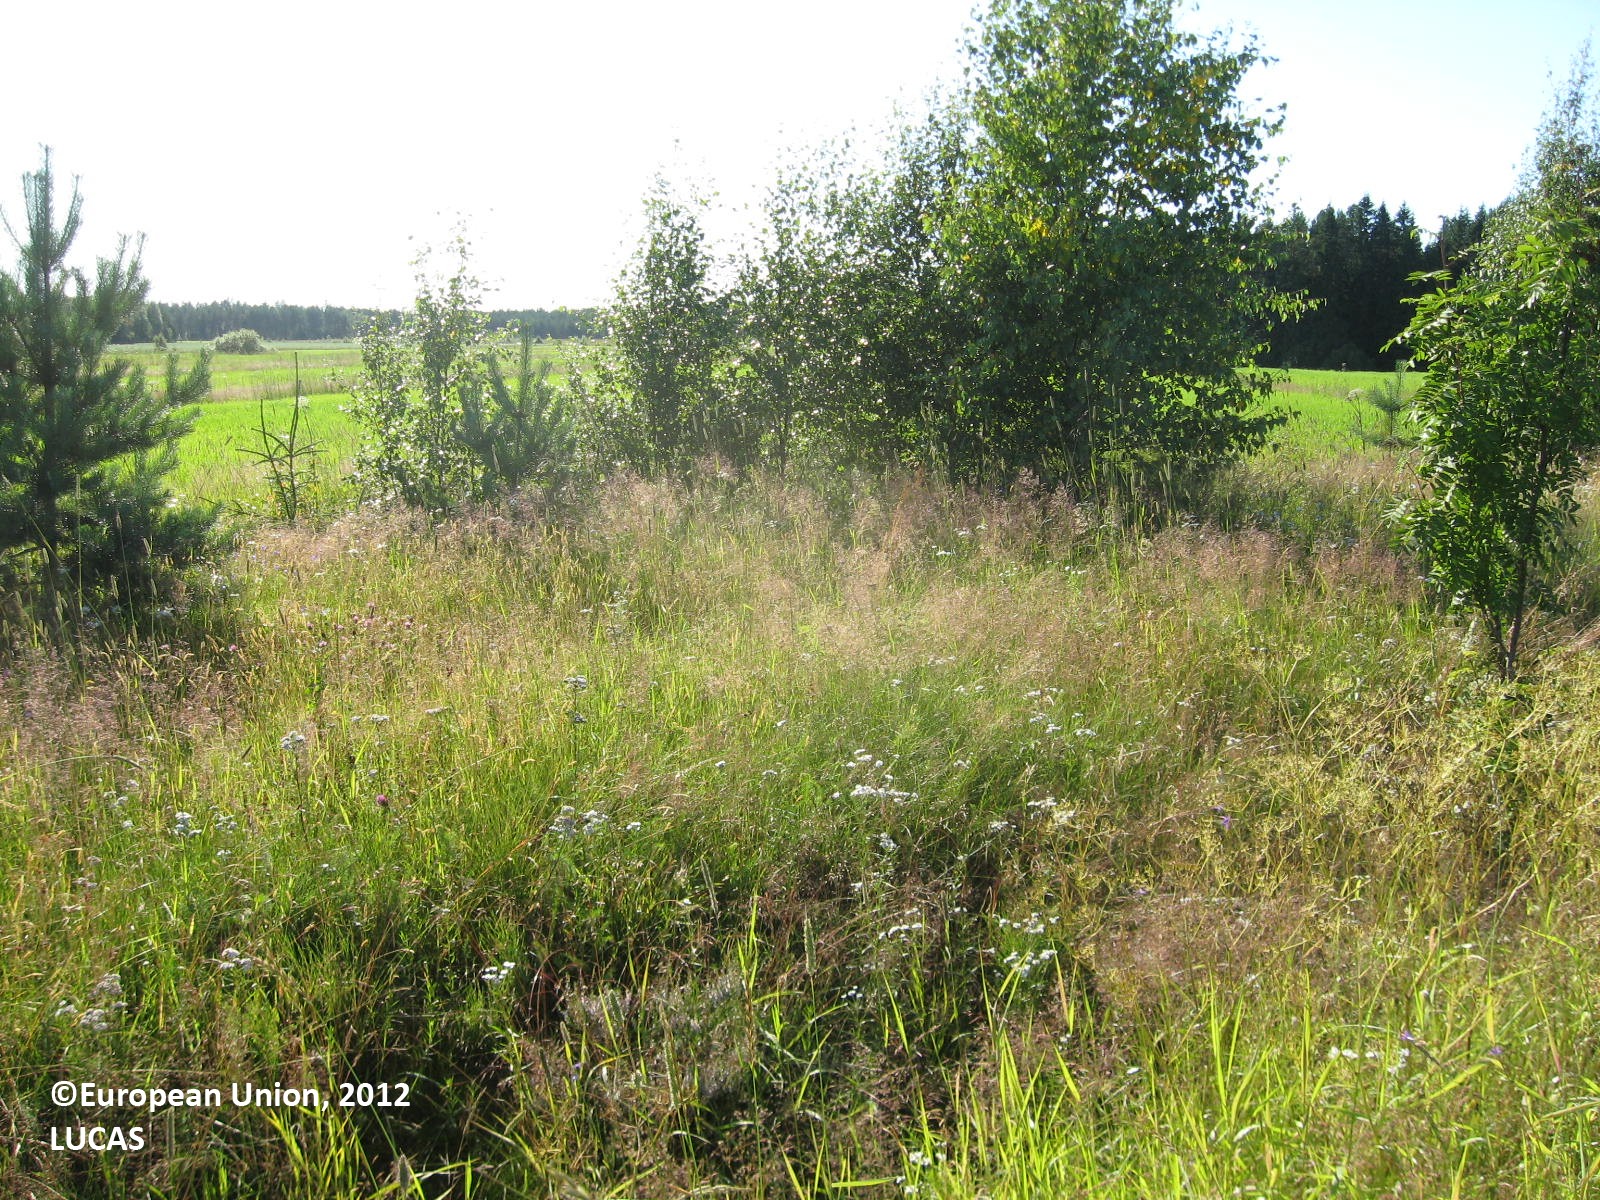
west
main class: Cropland
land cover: Oats
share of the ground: > 75 %
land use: Agriculture (excluding fallow land and kitchen gardens)
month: July
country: FI
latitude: 62.0516
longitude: 22.5105
